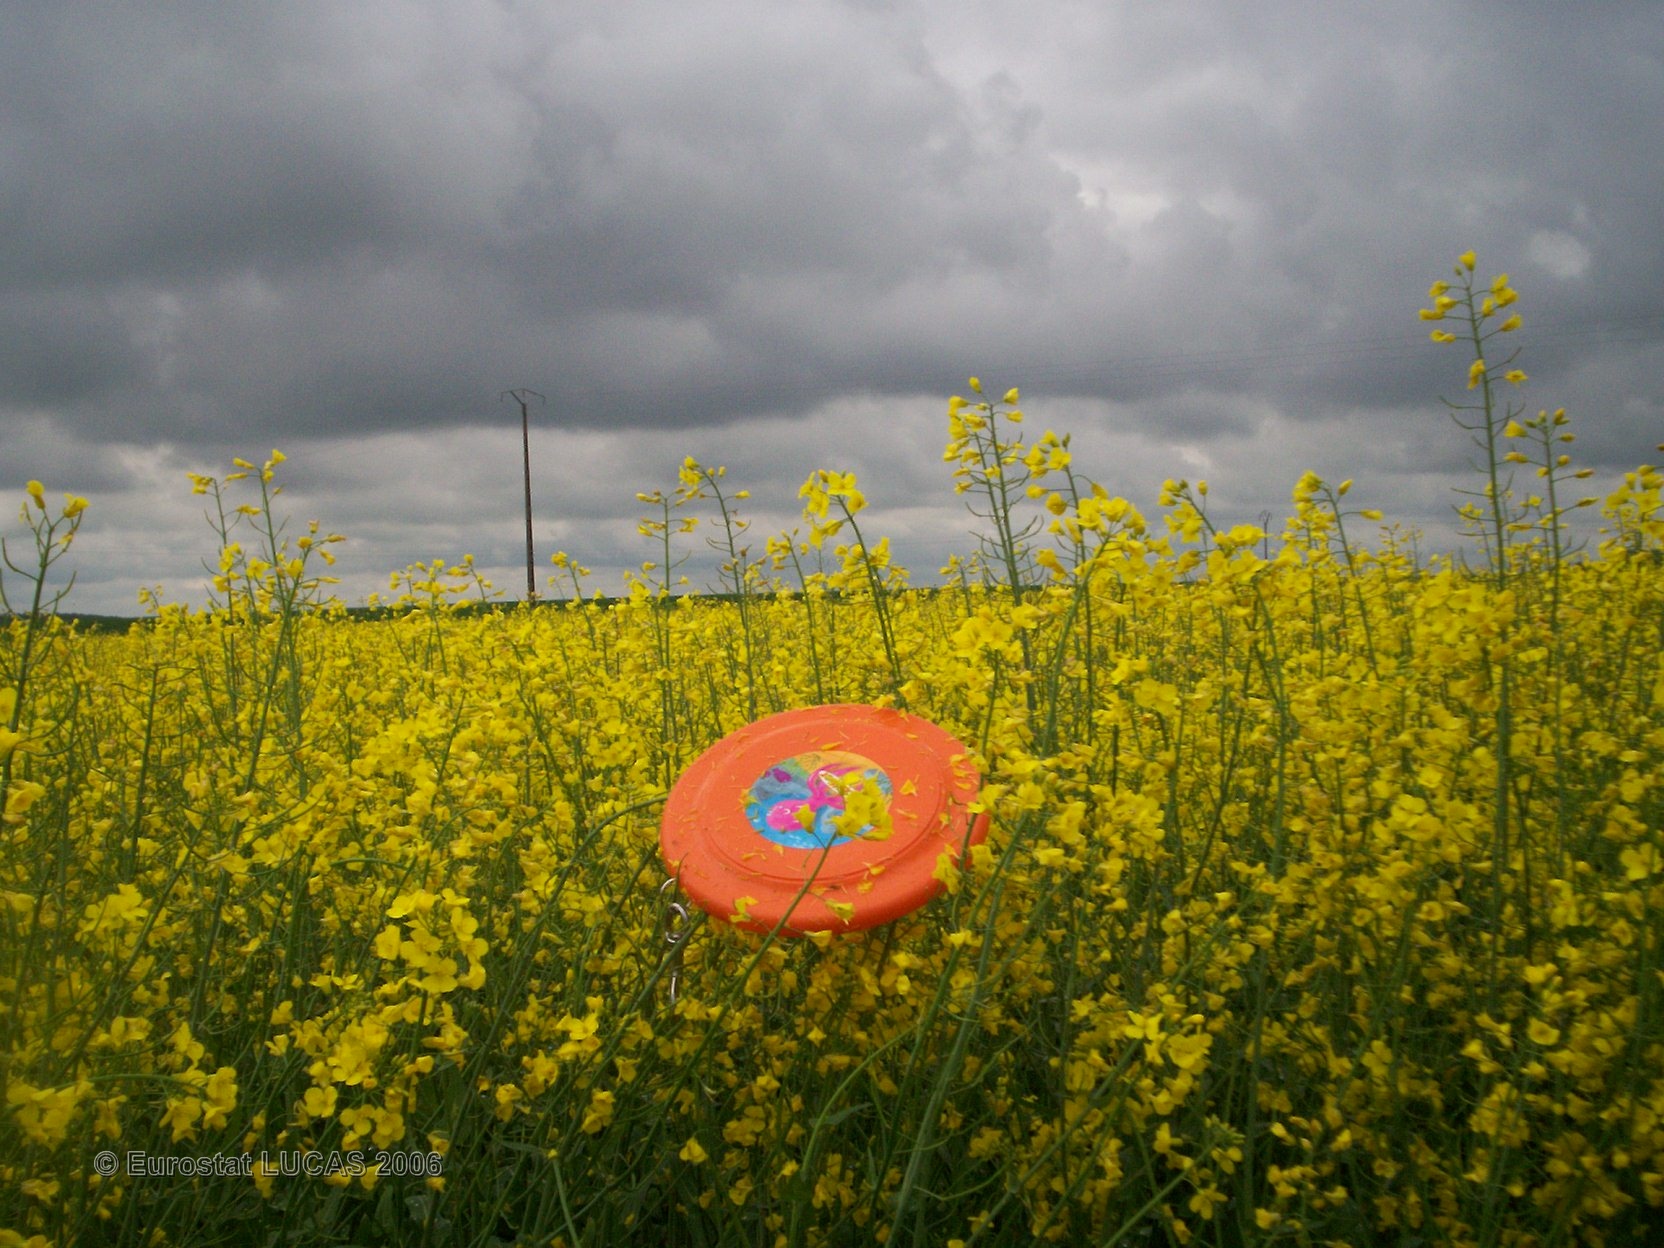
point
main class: Cropland
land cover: Rape and turnip rape
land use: Agriculture (excluding fallow land and kitchen gardens)
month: May
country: FR
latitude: 47.9445
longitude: 2.9641
